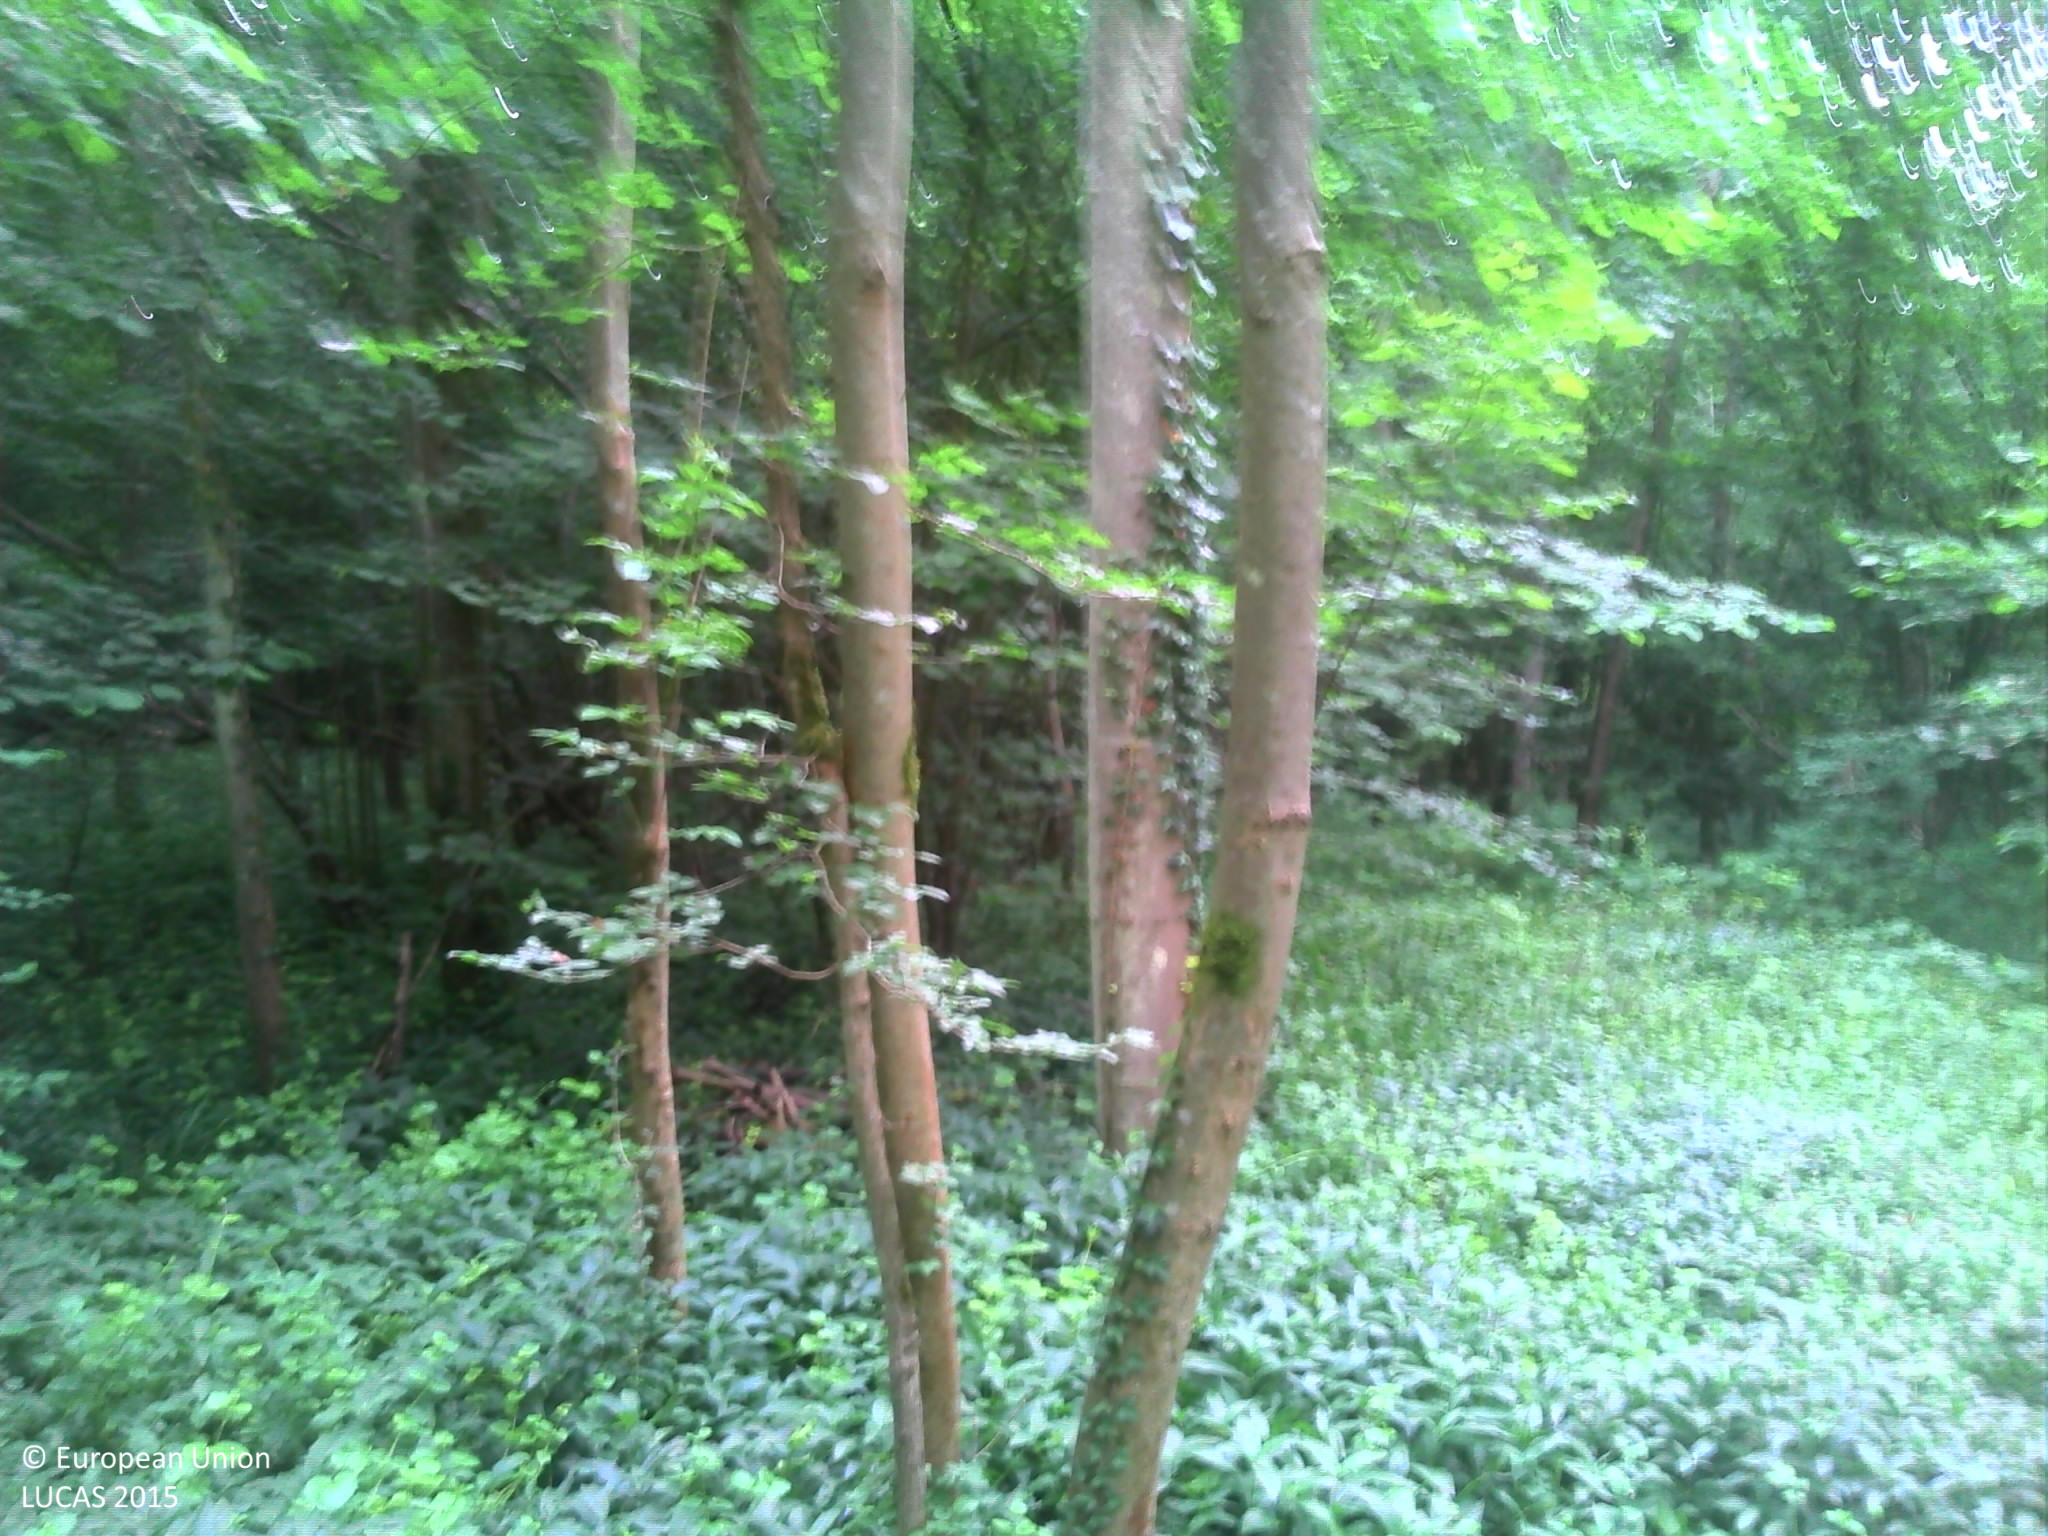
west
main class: Woodland
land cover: Broadleaved woodland
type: mesophytic deciduous forest
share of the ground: > 75 %
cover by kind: broadleaved forest trees 90 %, herbaceous plants 10 %
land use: Forestry
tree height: > 5 m
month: May
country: FR
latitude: 48.3226
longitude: 7.5599
